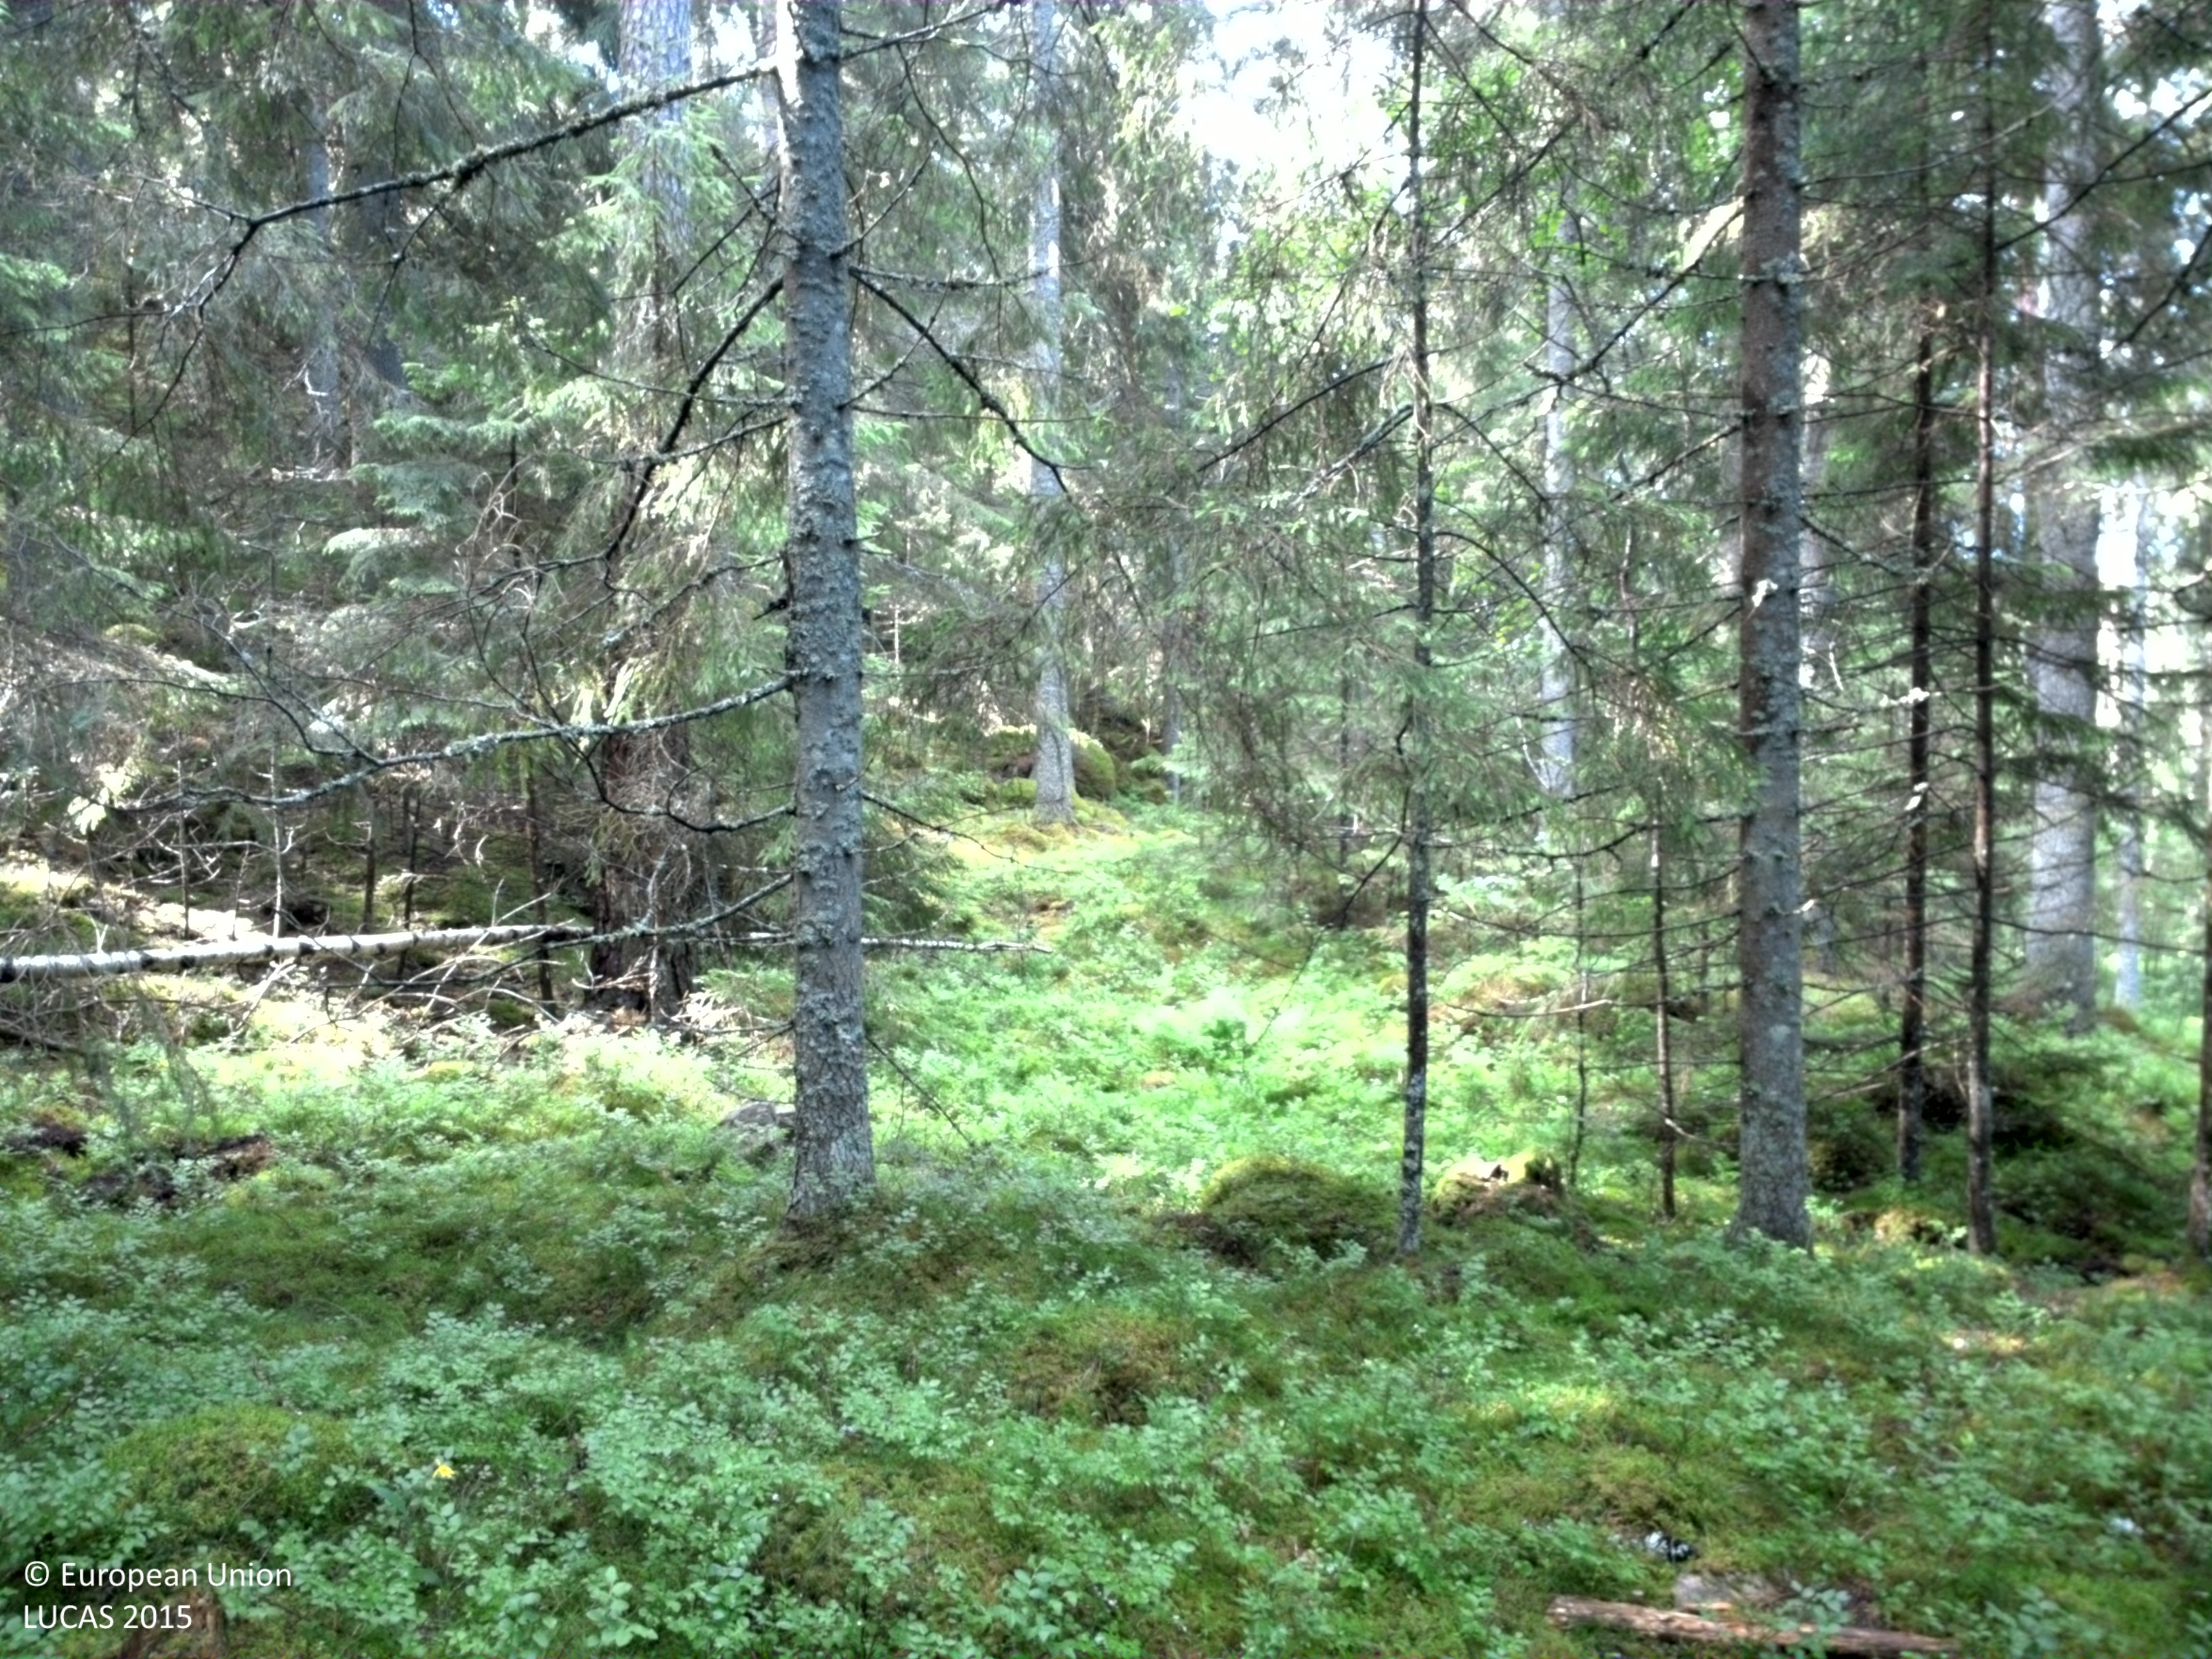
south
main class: Woodland
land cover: Spruce dominated coniferous woodland
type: boreal forest
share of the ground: 25 - 50 %
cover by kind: coniferous forest trees 40 %, lichens and mosses 35 %, herbaceous plants 25 %
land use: Forestry
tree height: > 5 m
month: July
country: SE
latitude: 58.7460
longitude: 15.7481
